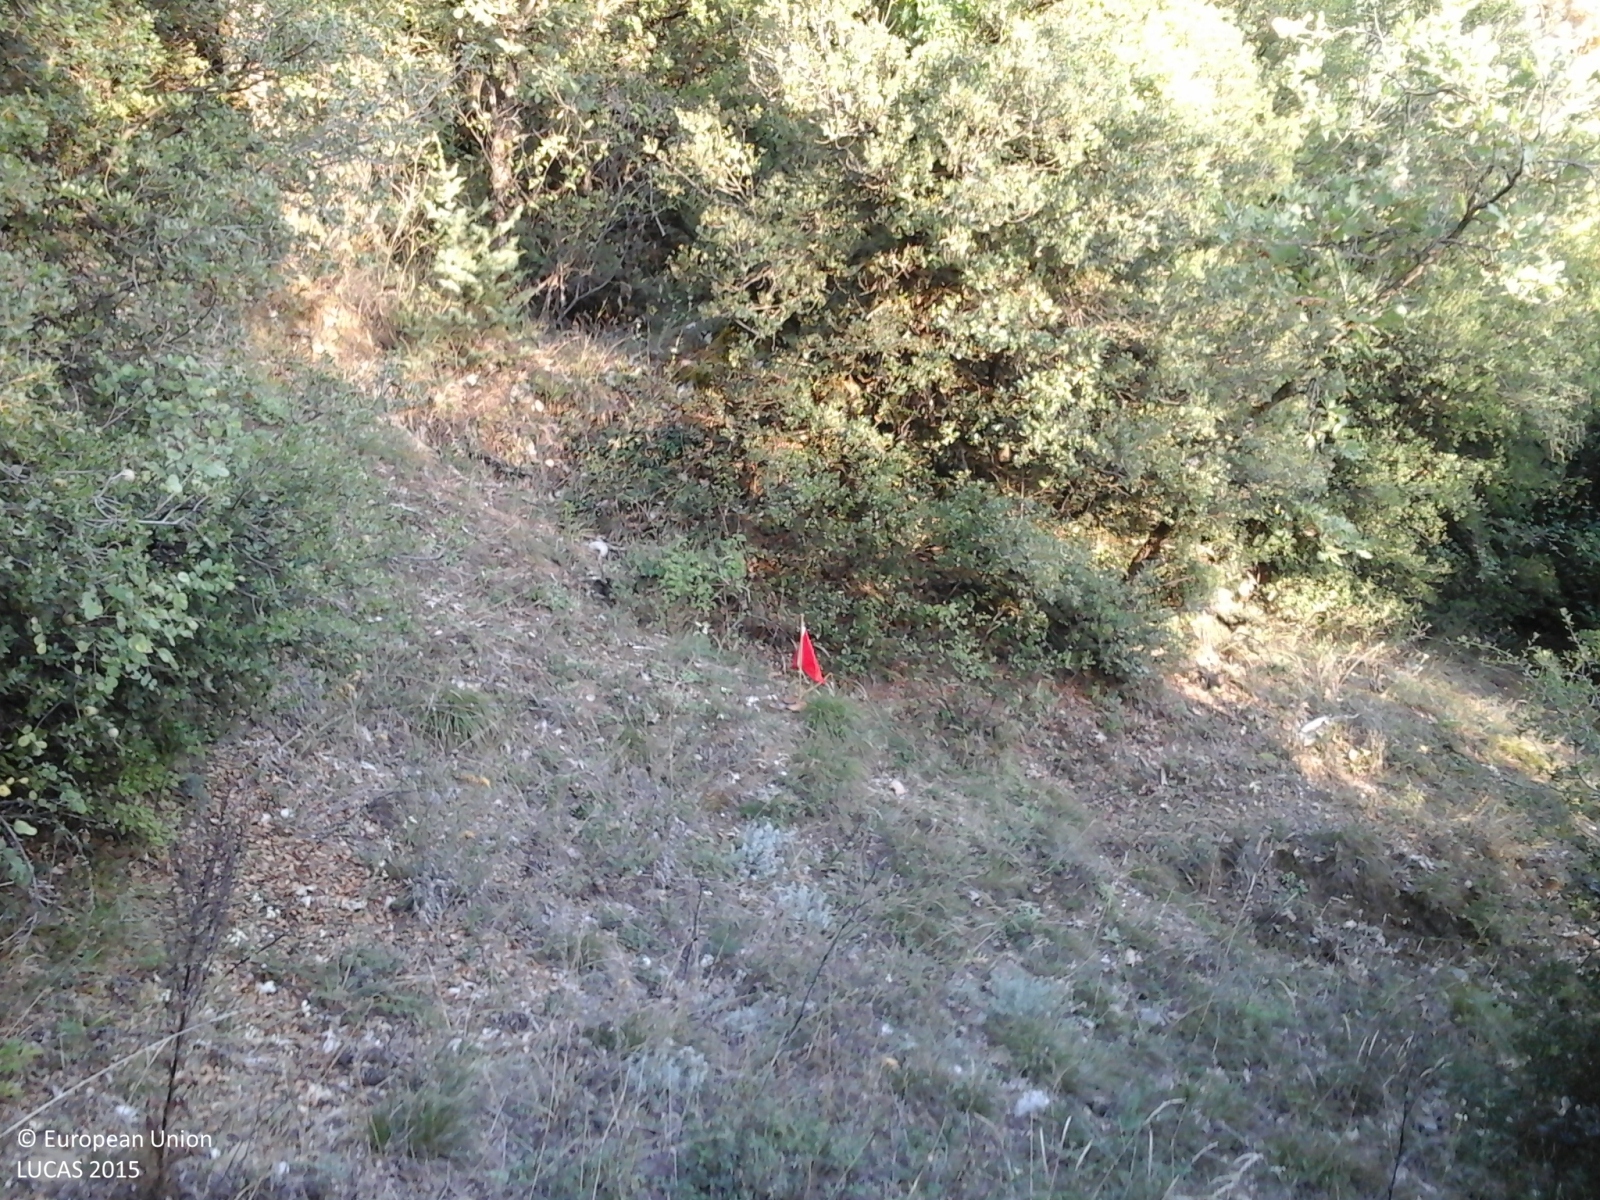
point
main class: Woodland
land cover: Broadleaved woodland
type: thermophilous deciduous forest
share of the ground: 25 - 50 %
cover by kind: shrubs 55 %, broadleaved forest trees 30 %, herbaceous plants 10 %, unconsolidated bare surface 5 %
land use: Semi-natural and natural areas not in use
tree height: > 5 m
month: September
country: GR
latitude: 39.9703
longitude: 20.7173
